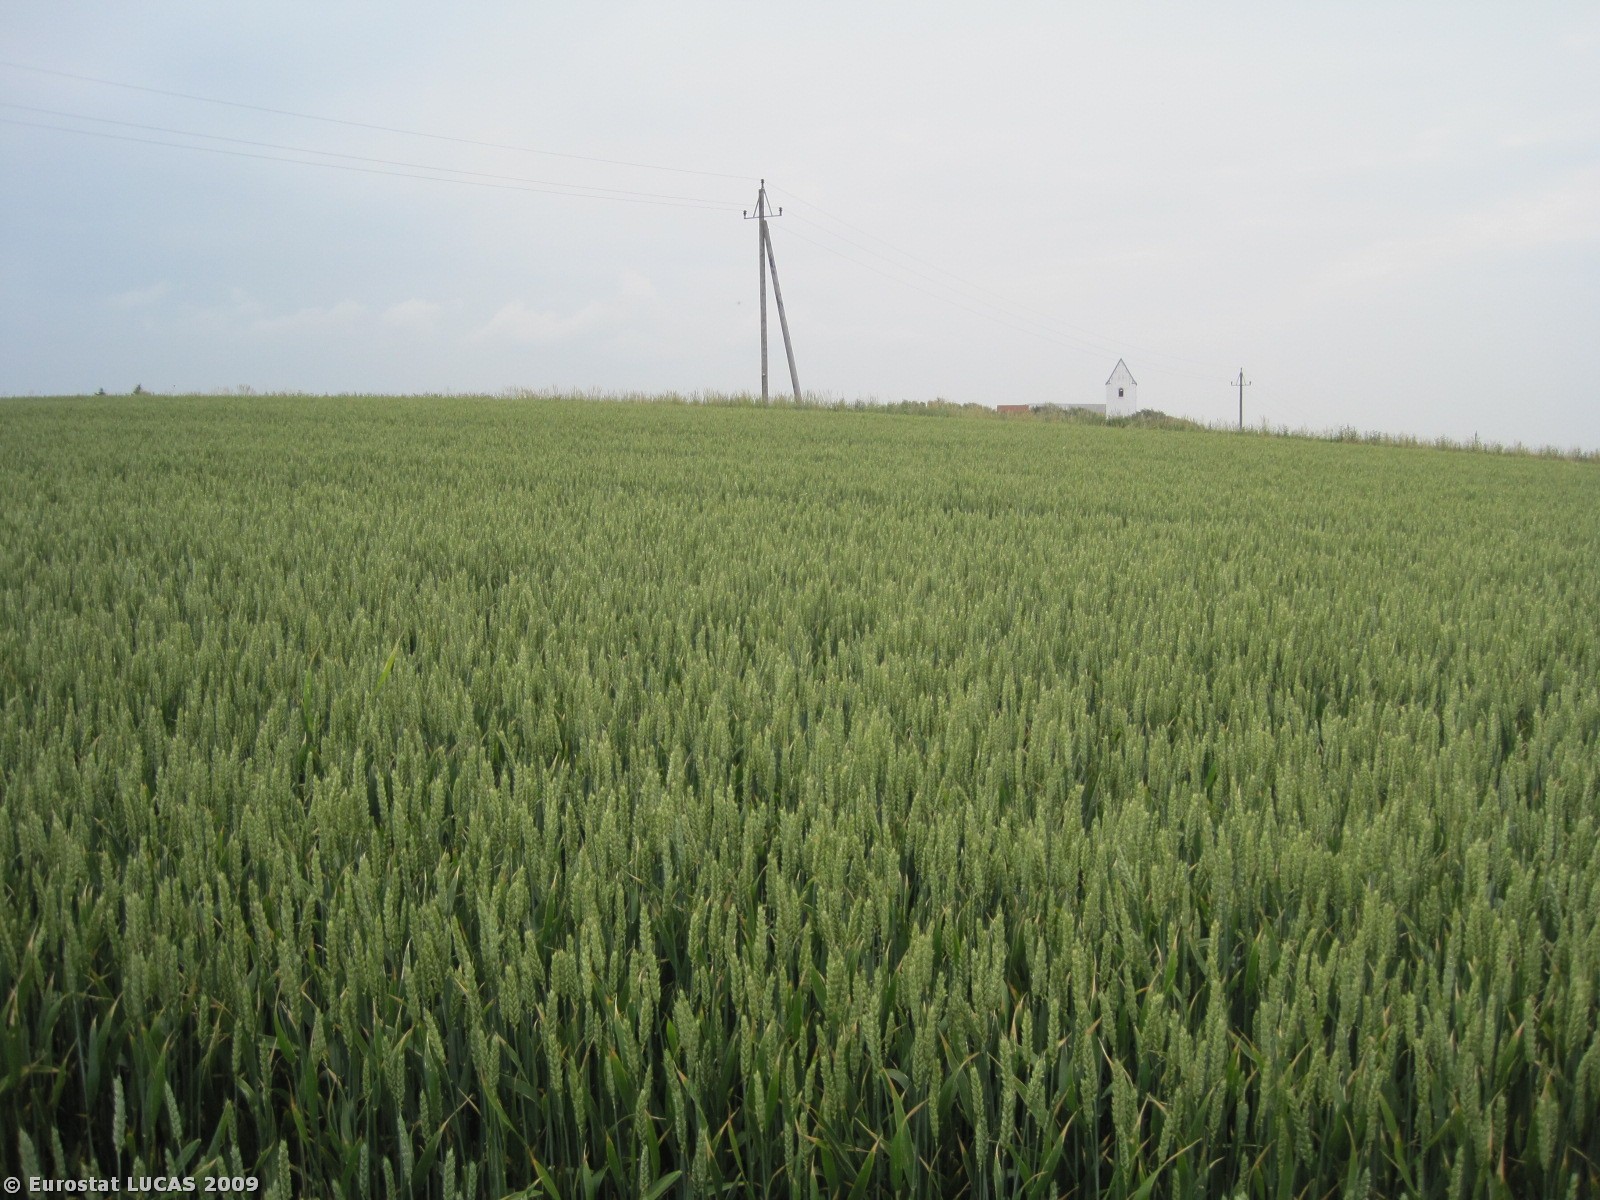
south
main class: Cropland
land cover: Common wheat
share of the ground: > 75 %
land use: Agriculture (excluding fallow land and kitchen gardens)
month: June
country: DK
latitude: 56.5716
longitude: 8.2606
